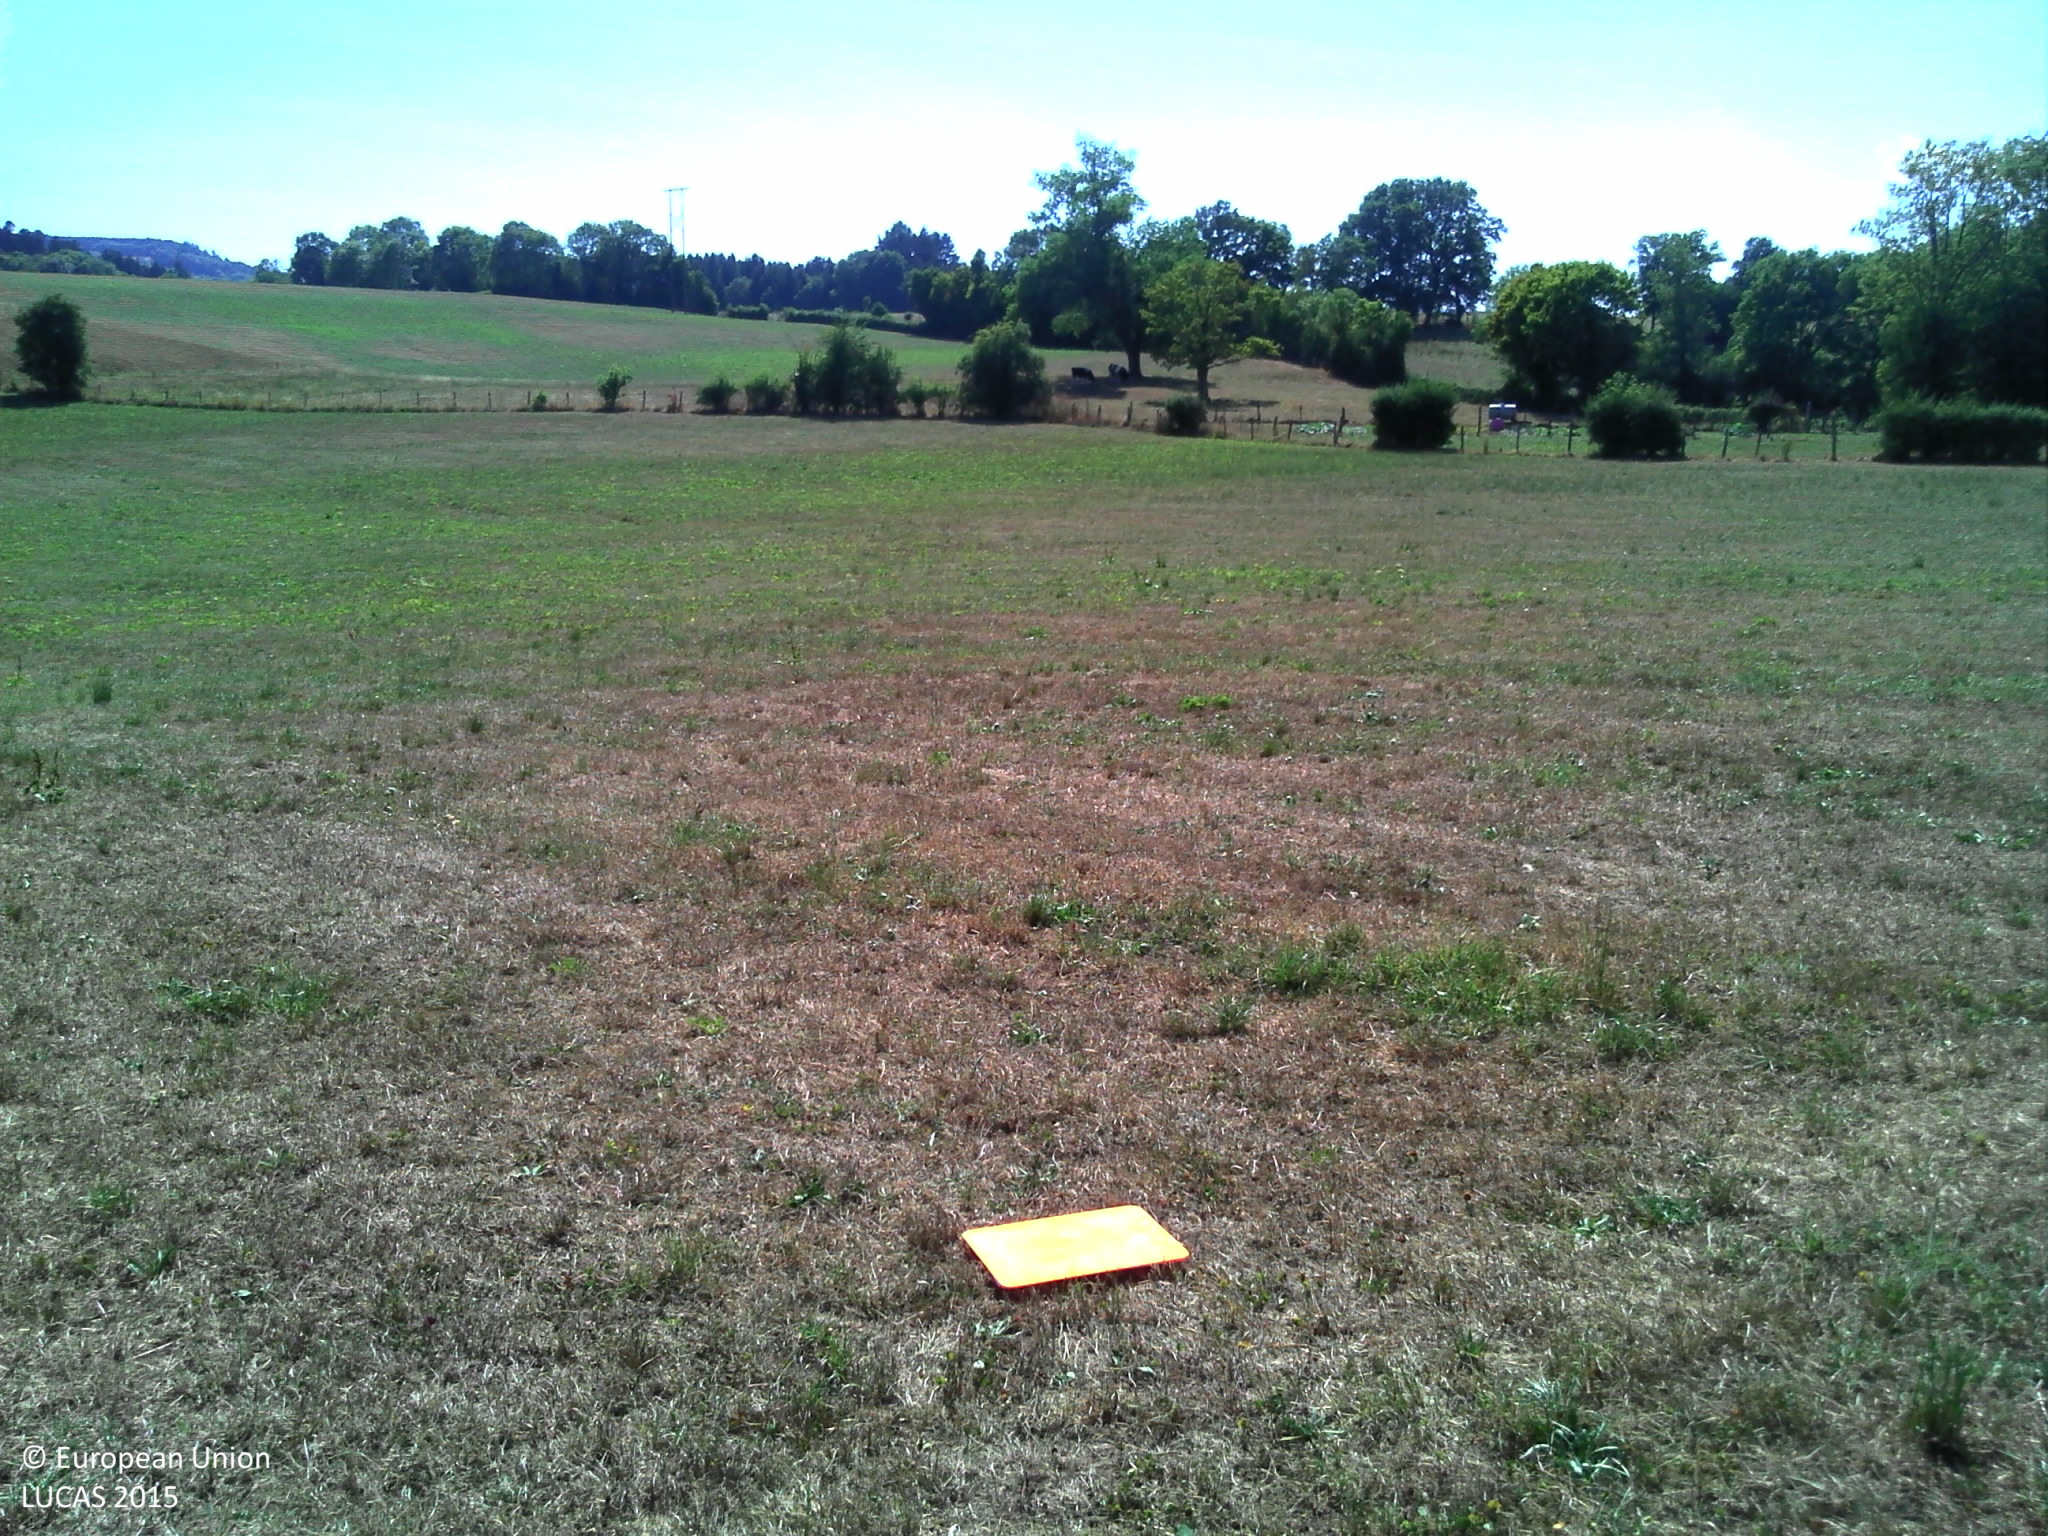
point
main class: Grassland
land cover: Grassland without tree/shrub cover
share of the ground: > 75 %
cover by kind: herbaceous plants 100 %
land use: Agriculture (excluding fallow land and kitchen gardens)
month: August
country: FR
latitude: 45.7136
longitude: 2.8437
